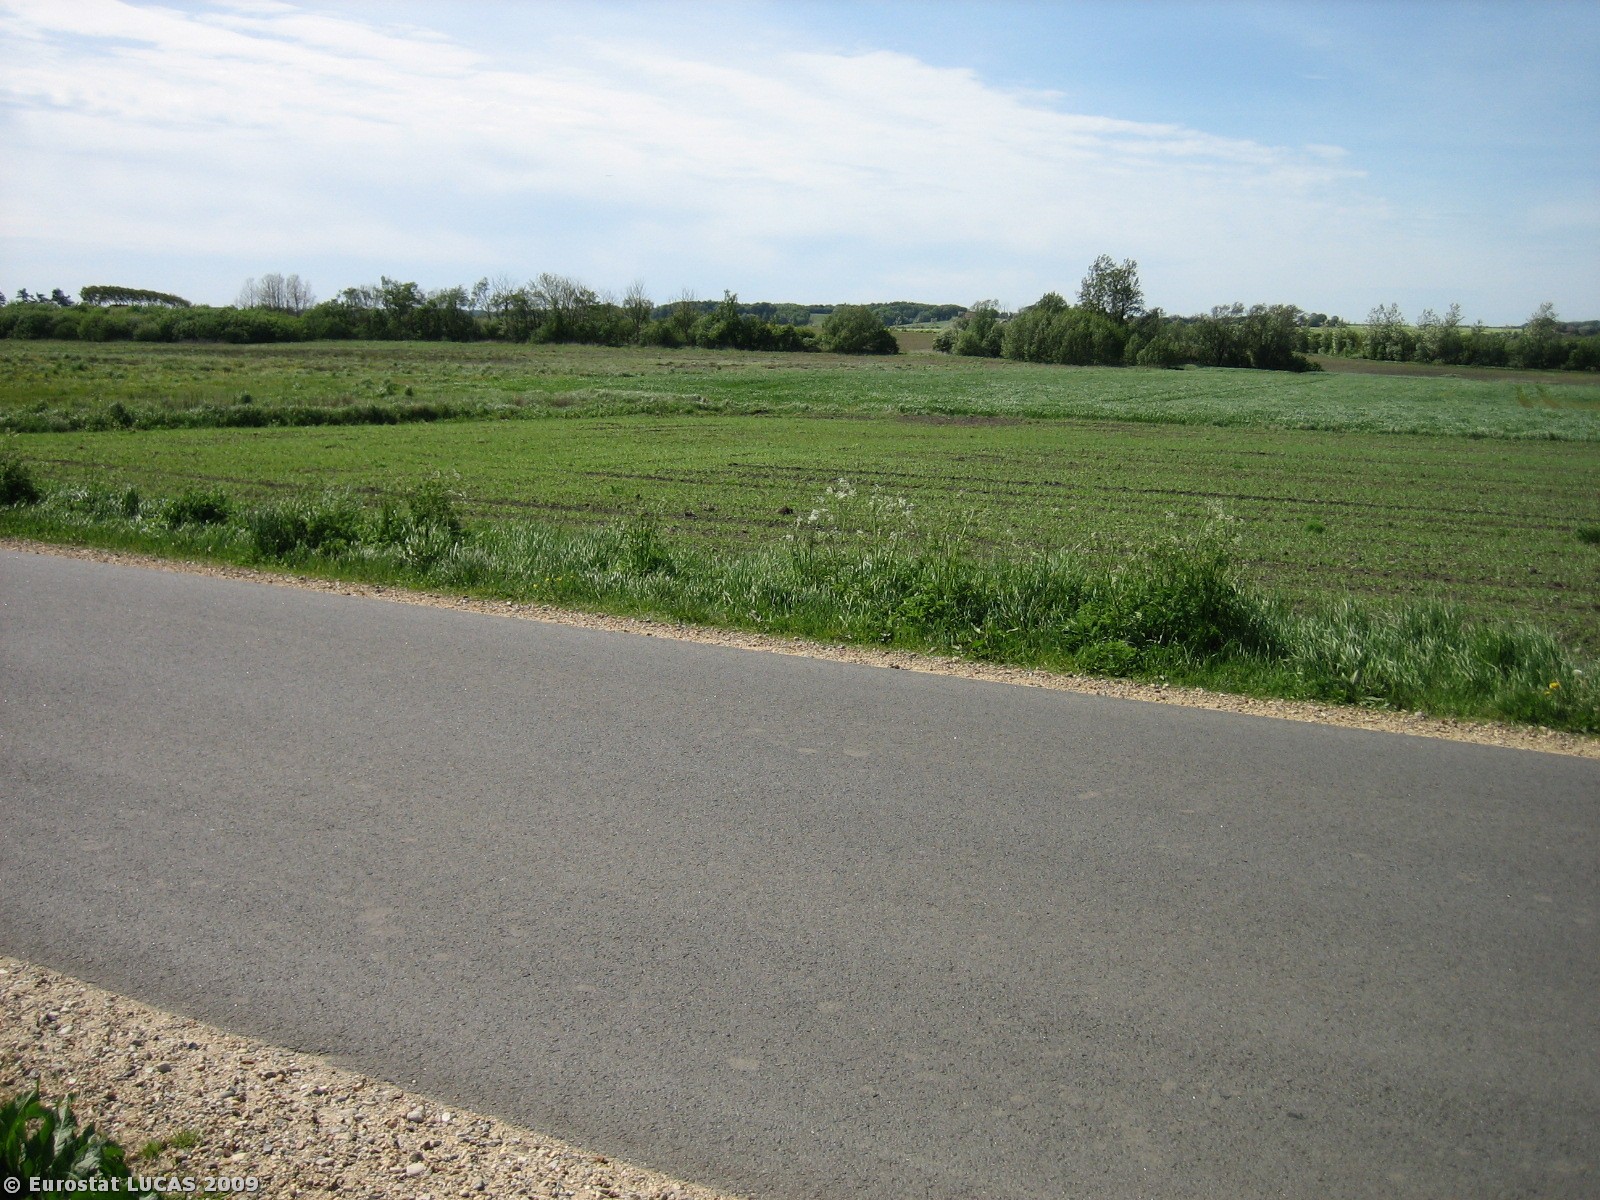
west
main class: Cropland
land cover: Rape and turnip rape
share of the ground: > 75 %
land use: Agriculture (excluding fallow land and kitchen gardens)
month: May
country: DK
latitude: 56.0177
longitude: 8.5417
